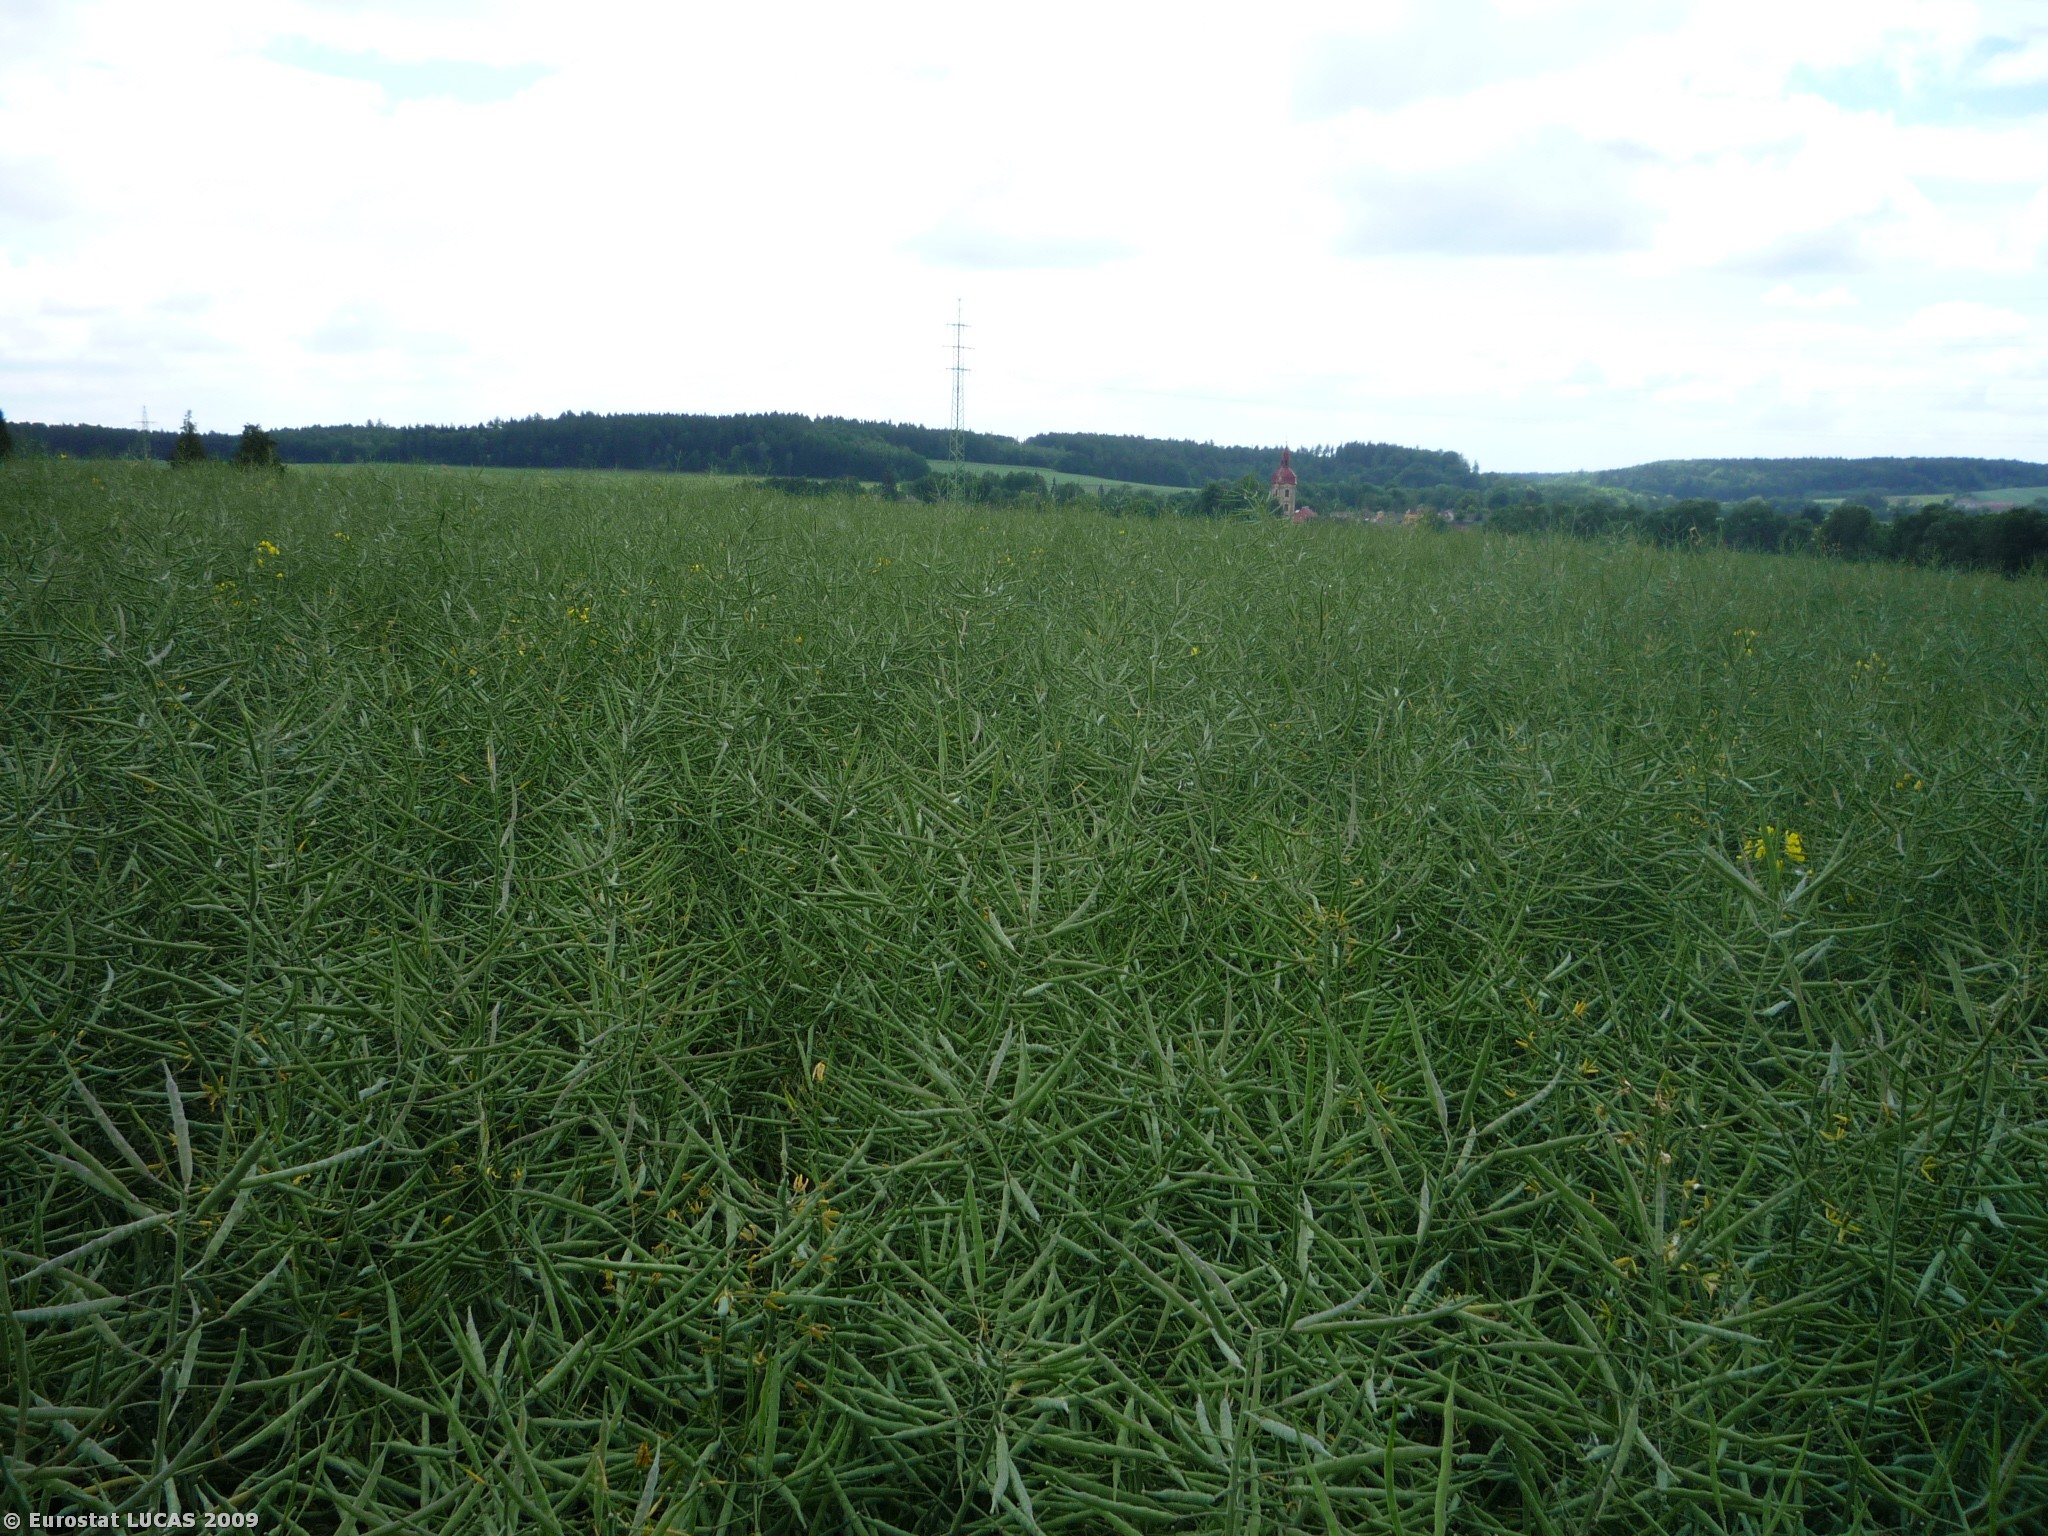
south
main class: Cropland
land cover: Rape and turnip rape
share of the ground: > 75 %
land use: Agriculture (excluding fallow land and kitchen gardens)
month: June
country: CZ
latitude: 50.3785
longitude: 15.8128
